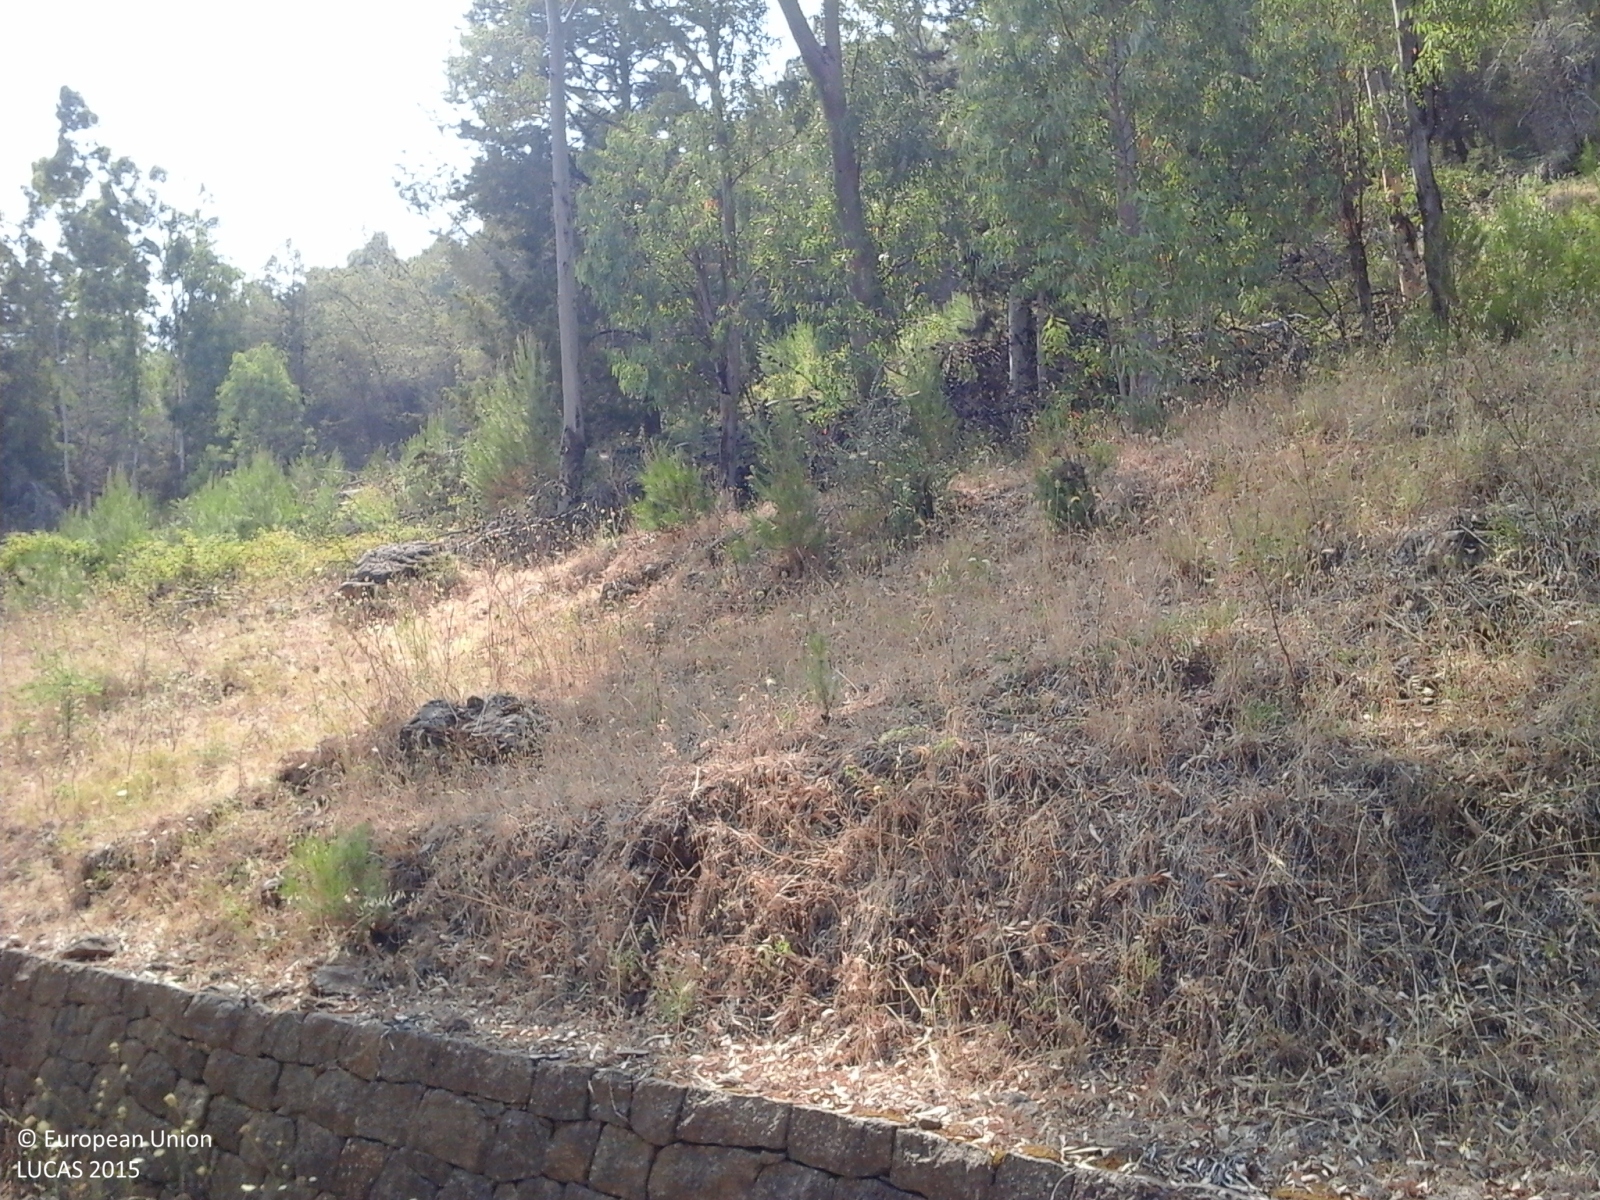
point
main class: Woodland
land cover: Other mixed woodland
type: broadleaved evergreen forest
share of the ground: > 75 %
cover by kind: herbaceous plants 50 %, coniferous forest trees 20 %, broadleaved forest trees 20 %, shrubs 10 %
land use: Forestry
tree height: > 5 m
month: July
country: IT
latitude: 37.2082
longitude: 14.7975
